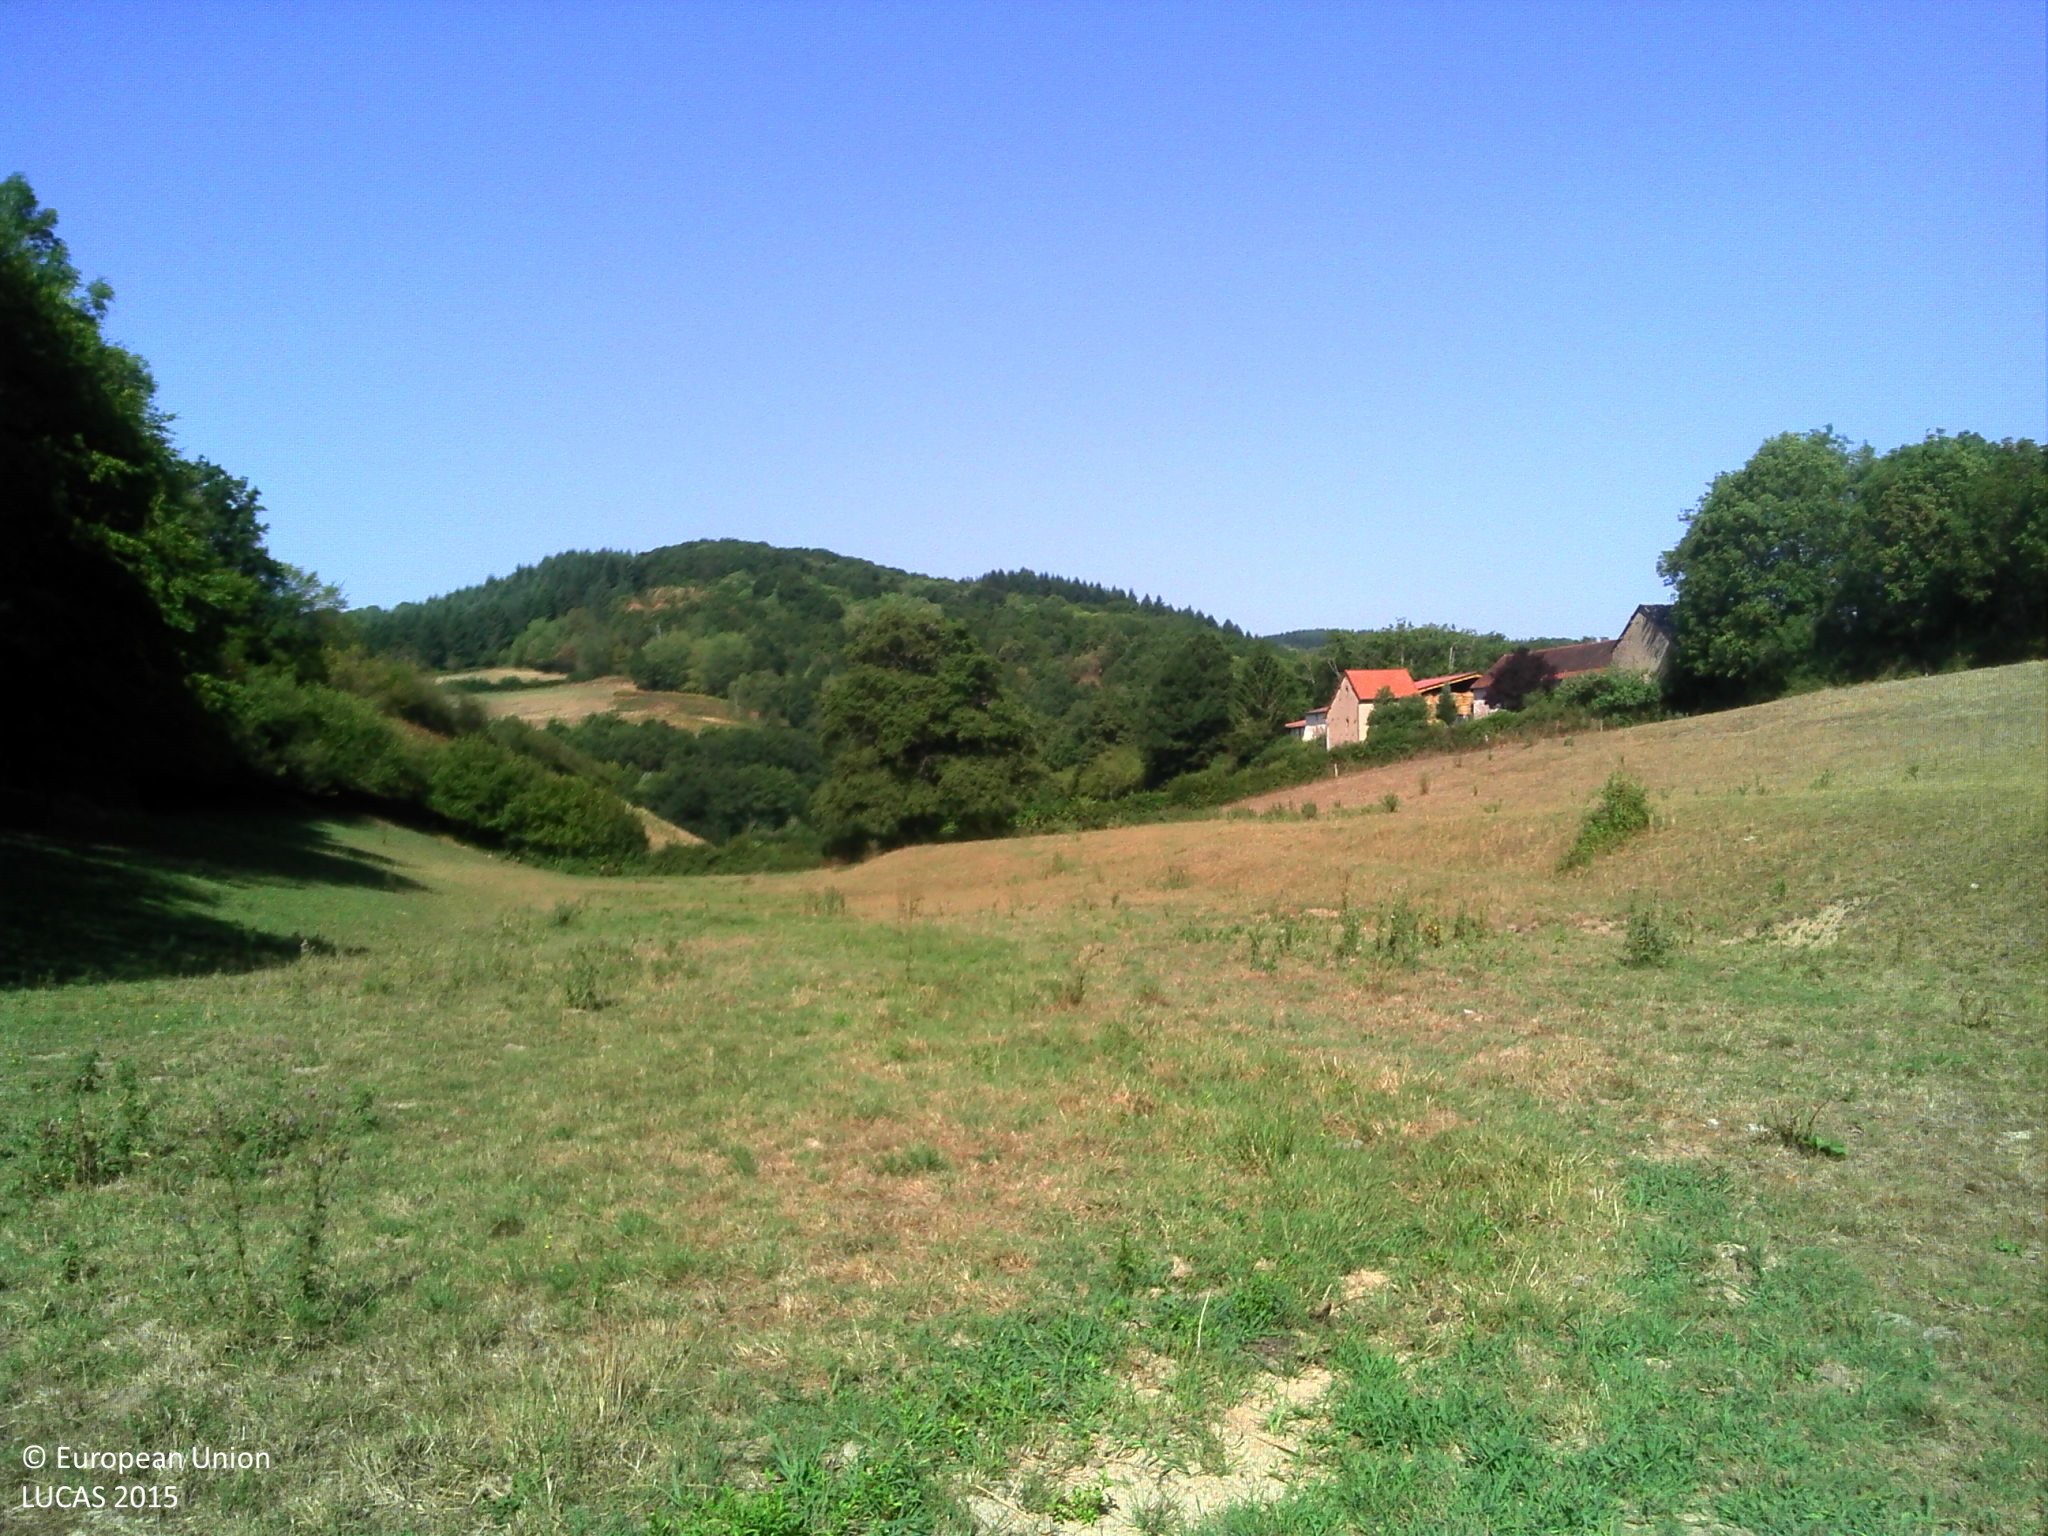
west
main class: Grassland
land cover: Grassland without tree/shrub cover
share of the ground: > 75 %
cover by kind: herbaceous plants 100 %
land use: Agriculture (excluding fallow land and kitchen gardens)
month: August
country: FR
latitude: 46.8171
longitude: 4.3776
